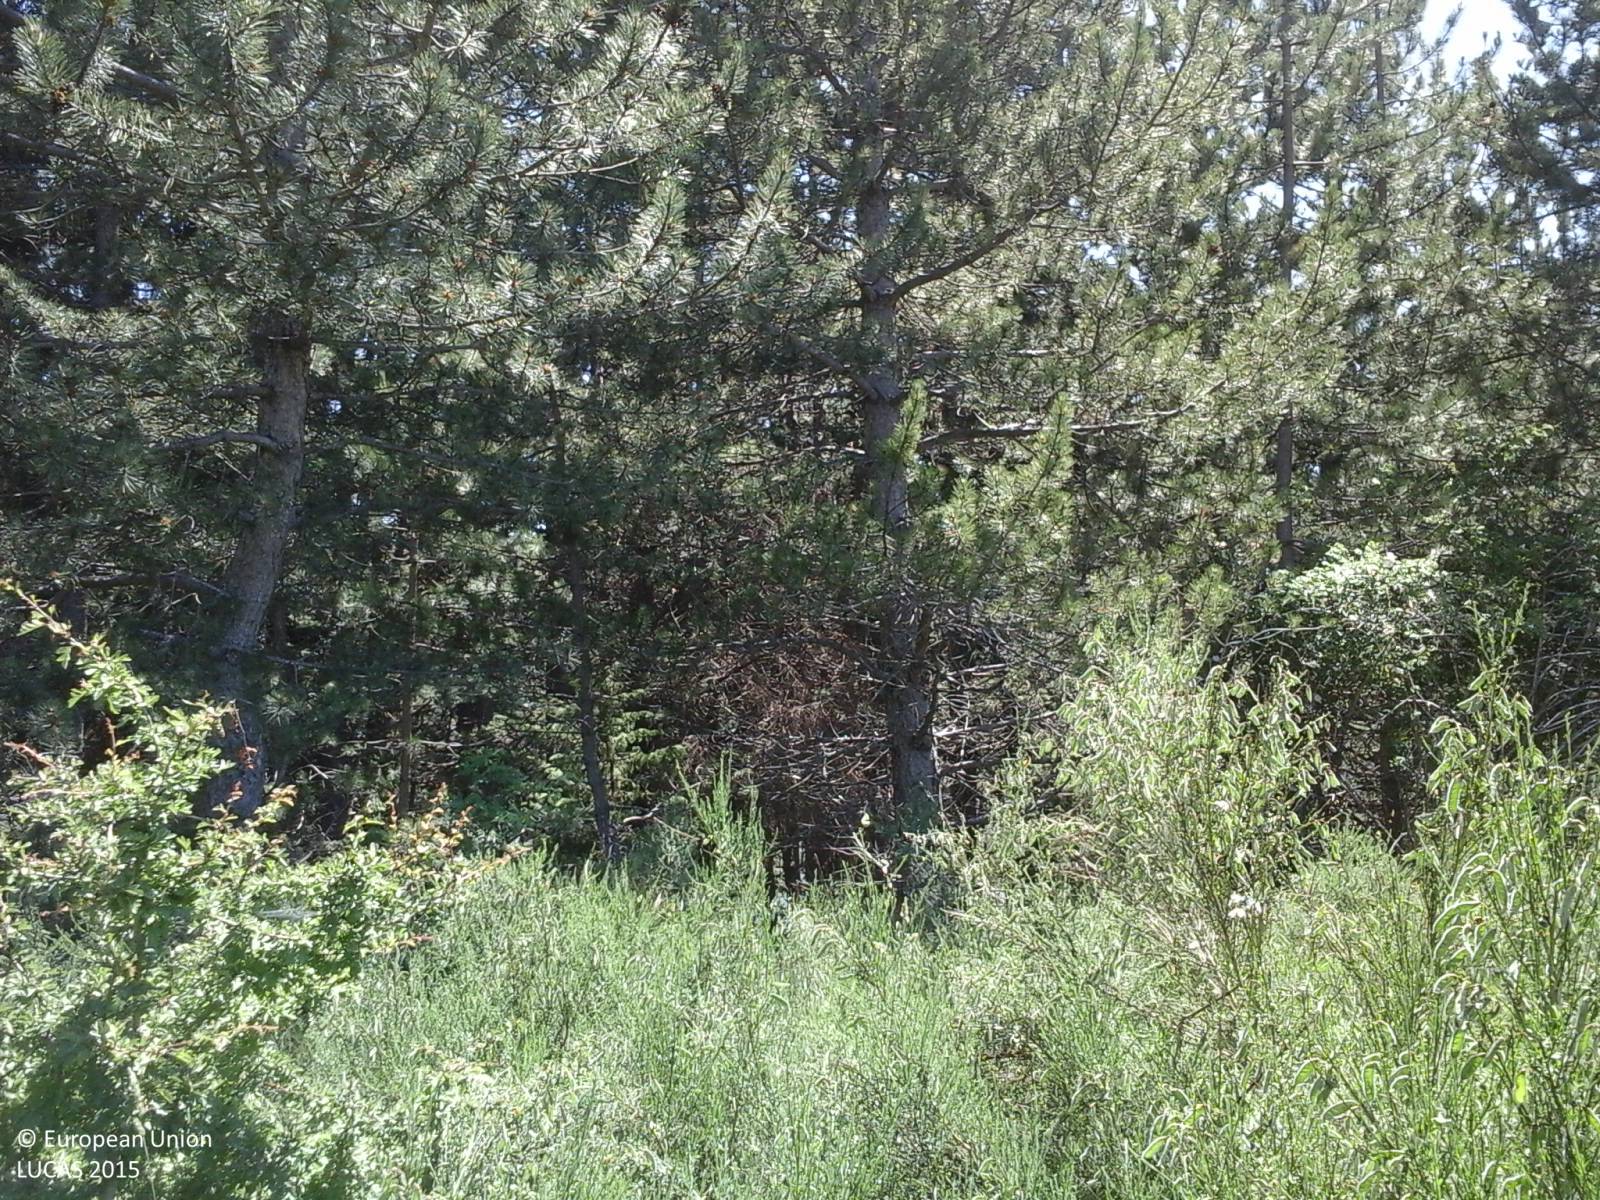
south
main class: Shrubland
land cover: Shrubland with sparse tree cover
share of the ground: > 75 %
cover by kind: shrubs 60 %, herbaceous plants 35 %, broadleaved forest trees 5 %
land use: Semi-natural and natural areas not in use
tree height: > 5 m
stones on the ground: < 10 %
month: July
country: IT
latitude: 42.5628
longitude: 13.3394
